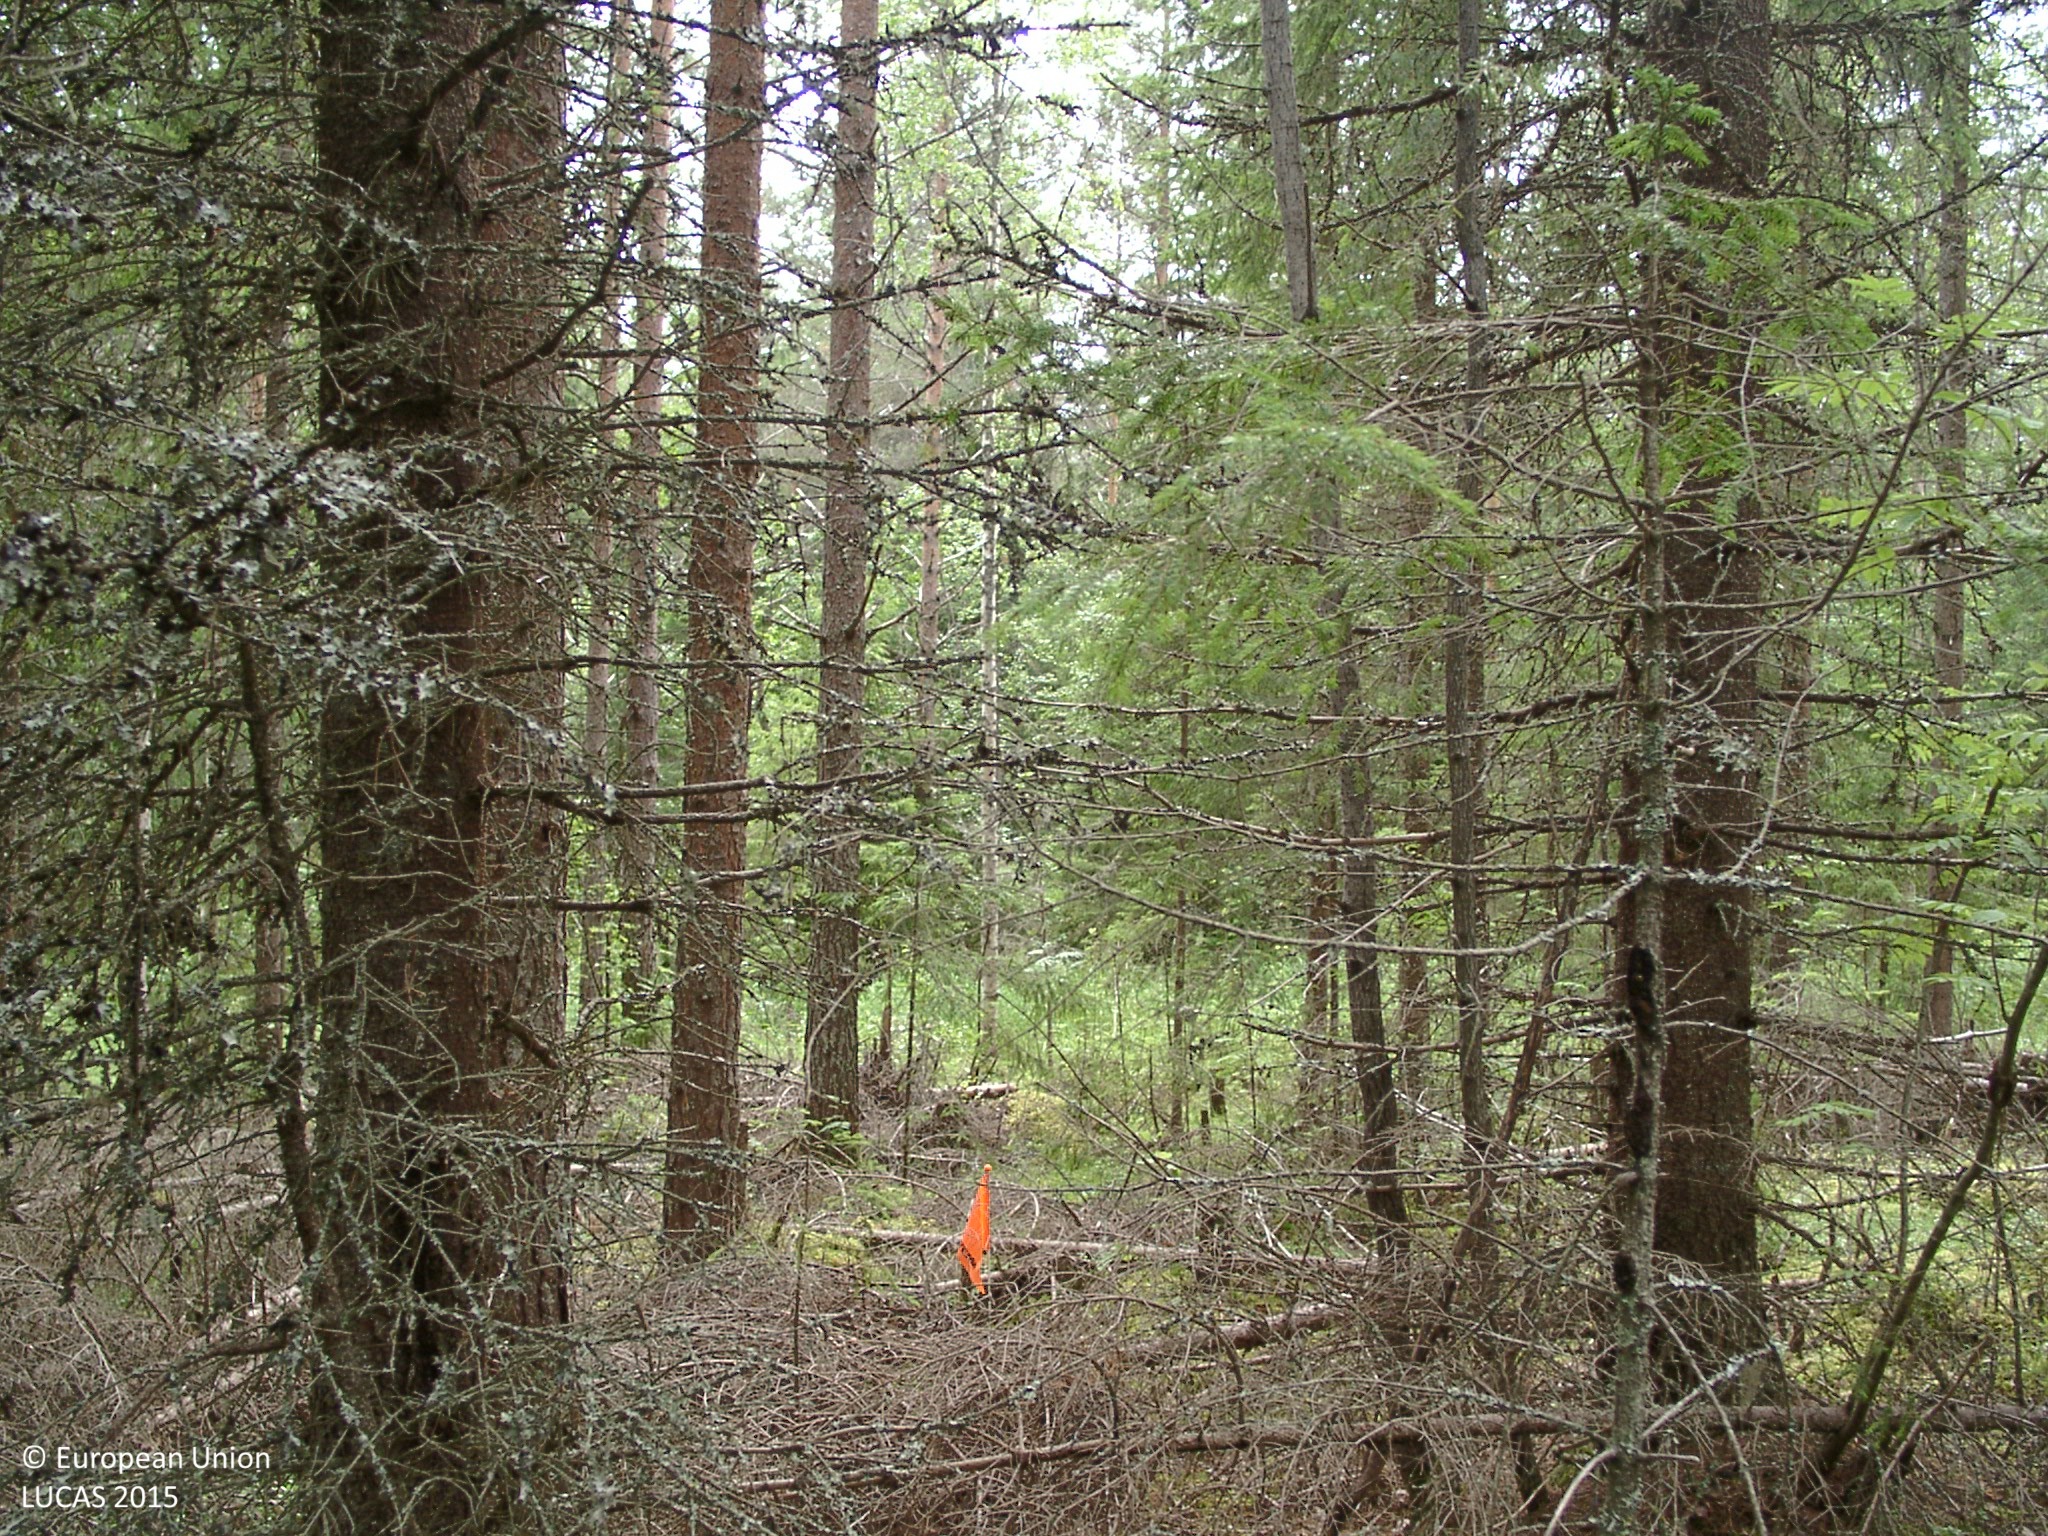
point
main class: Woodland
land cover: Other coniferous woodland
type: boreal forest
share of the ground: 50 - 75 %
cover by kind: coniferous forest trees 55 %, broadleaved forest trees 15 %, shrubs 10 %, herbaceous plants 5 %, lichens and mosses 5 %
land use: Forestry
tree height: > 5 m
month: July
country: FI
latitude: 62.2866
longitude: 25.2781
